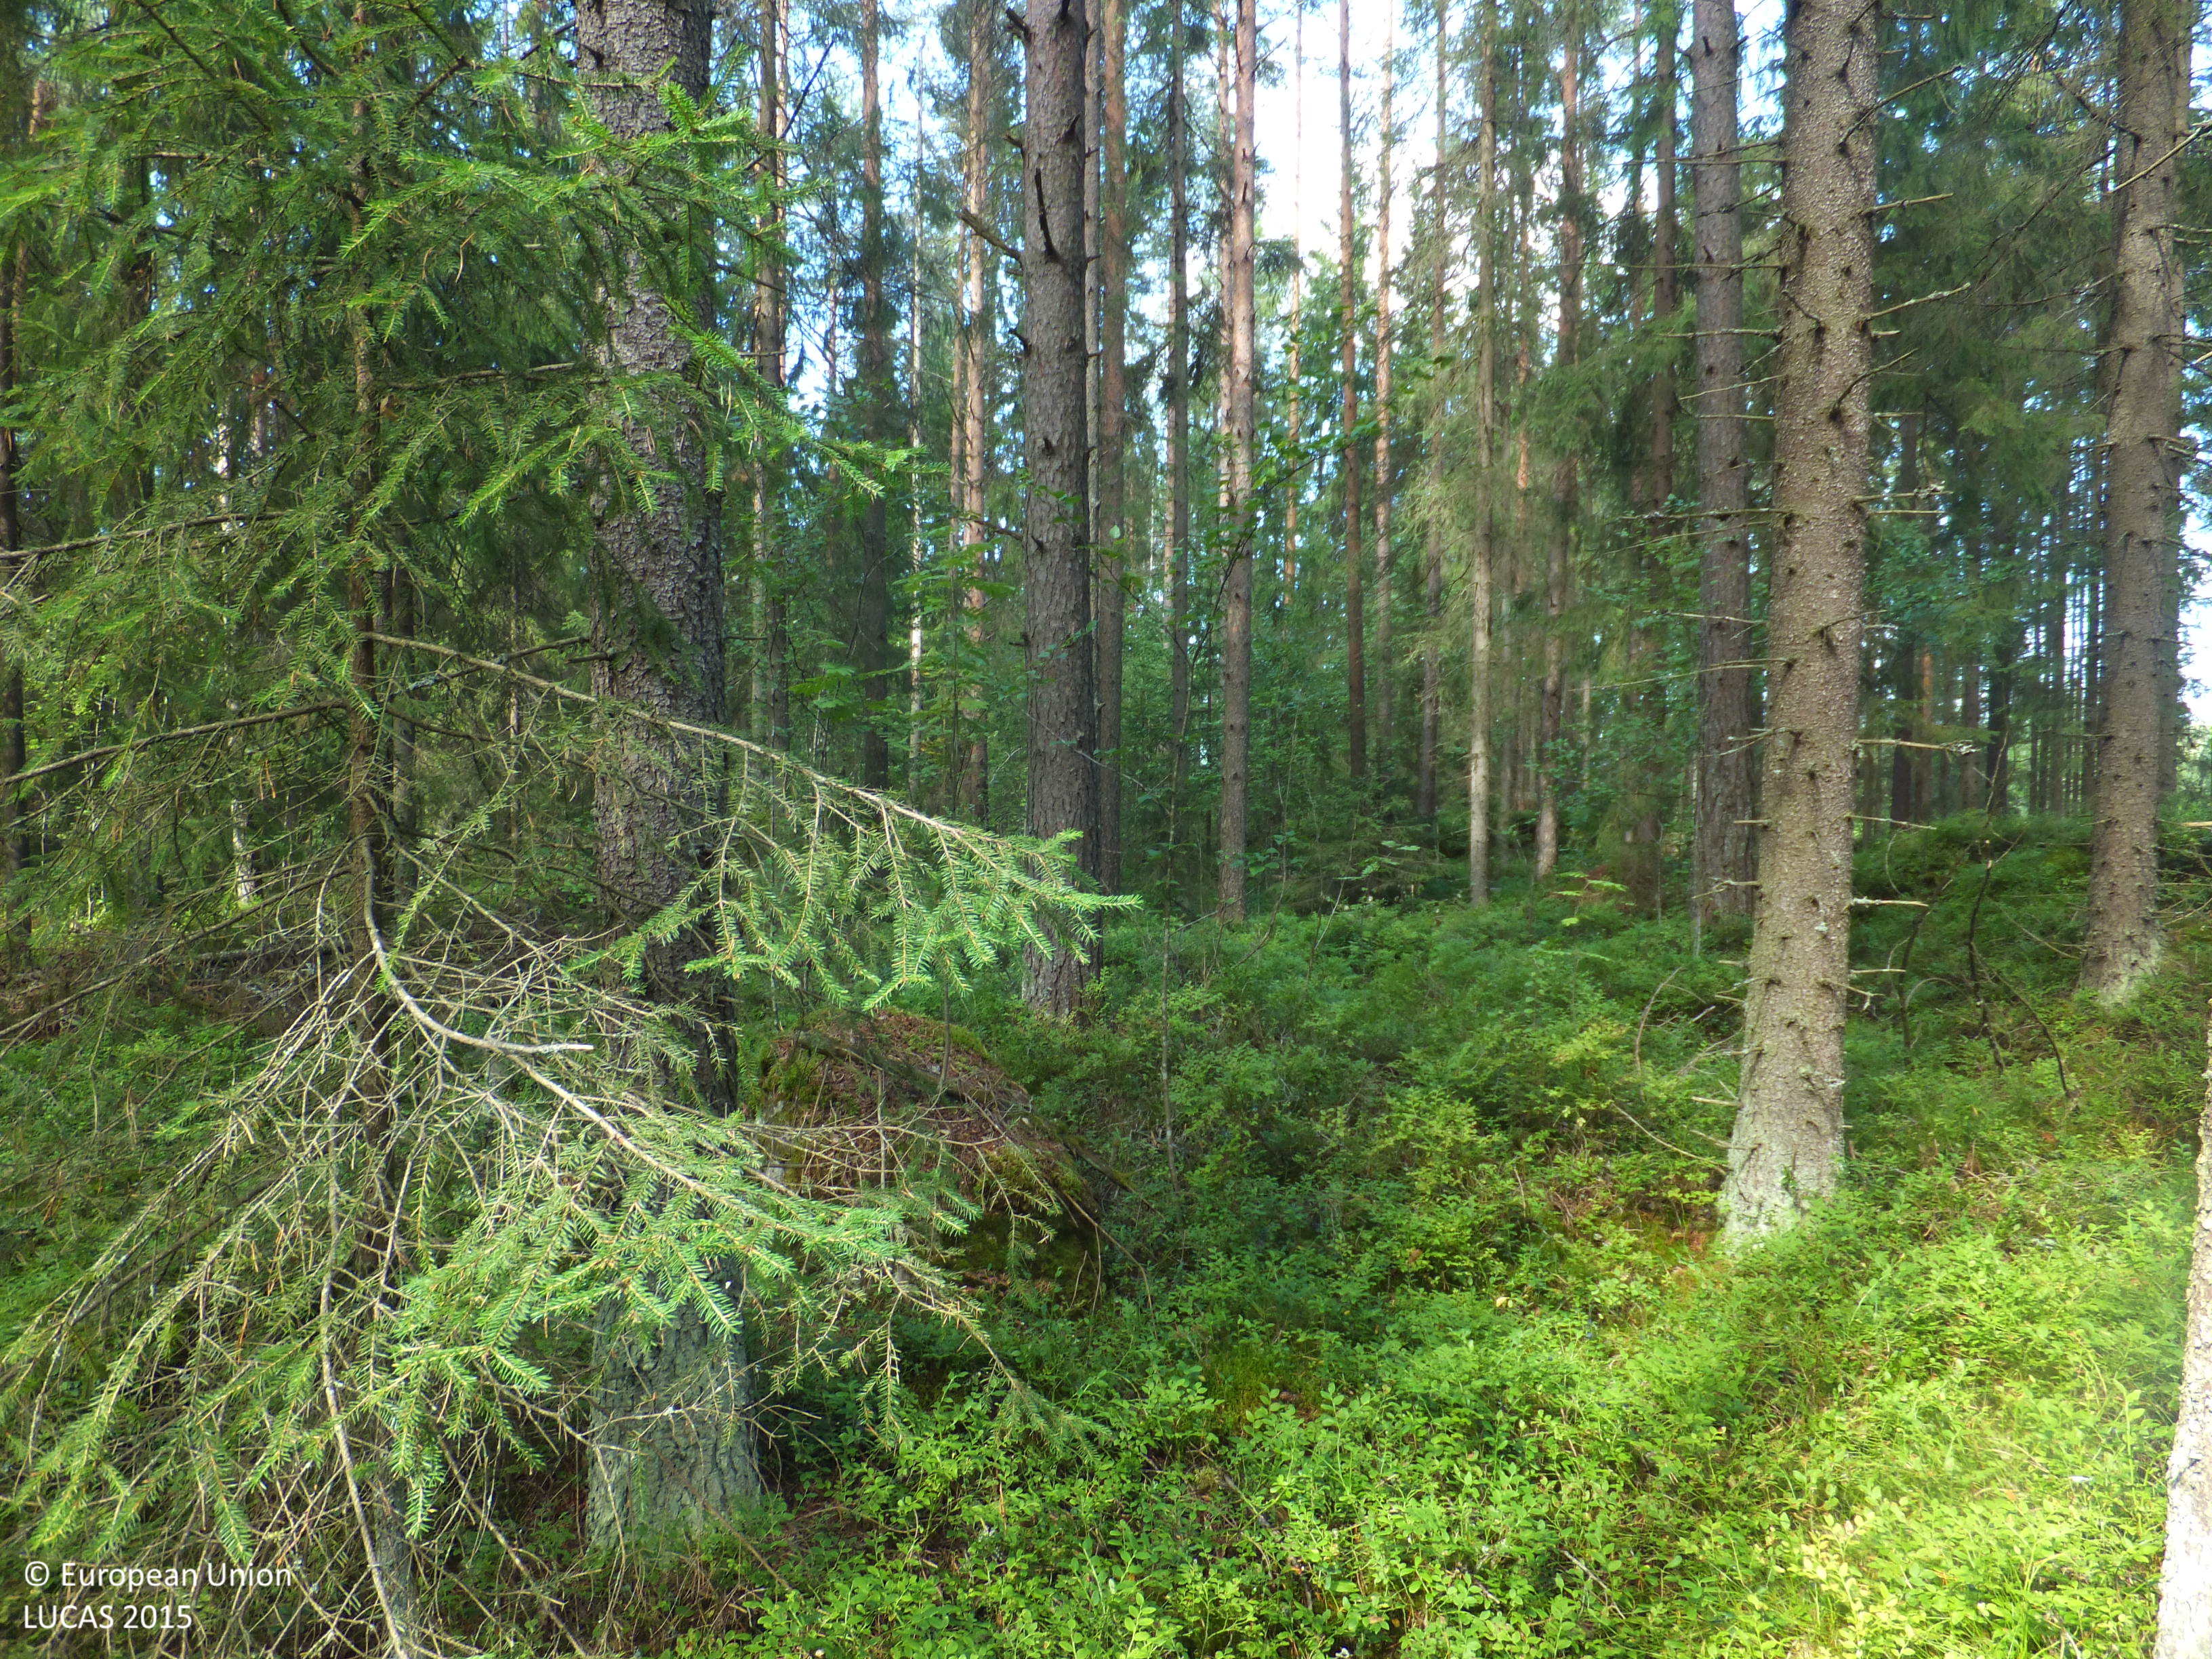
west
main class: Woodland
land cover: Other coniferous woodland
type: boreal forest
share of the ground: > 75 %
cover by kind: coniferous forest trees 75 %, shrubs 10 %, lichens and mosses 10 %, broadleaved forest trees 5 %
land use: Forestry
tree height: > 5 m
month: August
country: FI
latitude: 63.2292
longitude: 23.0924
